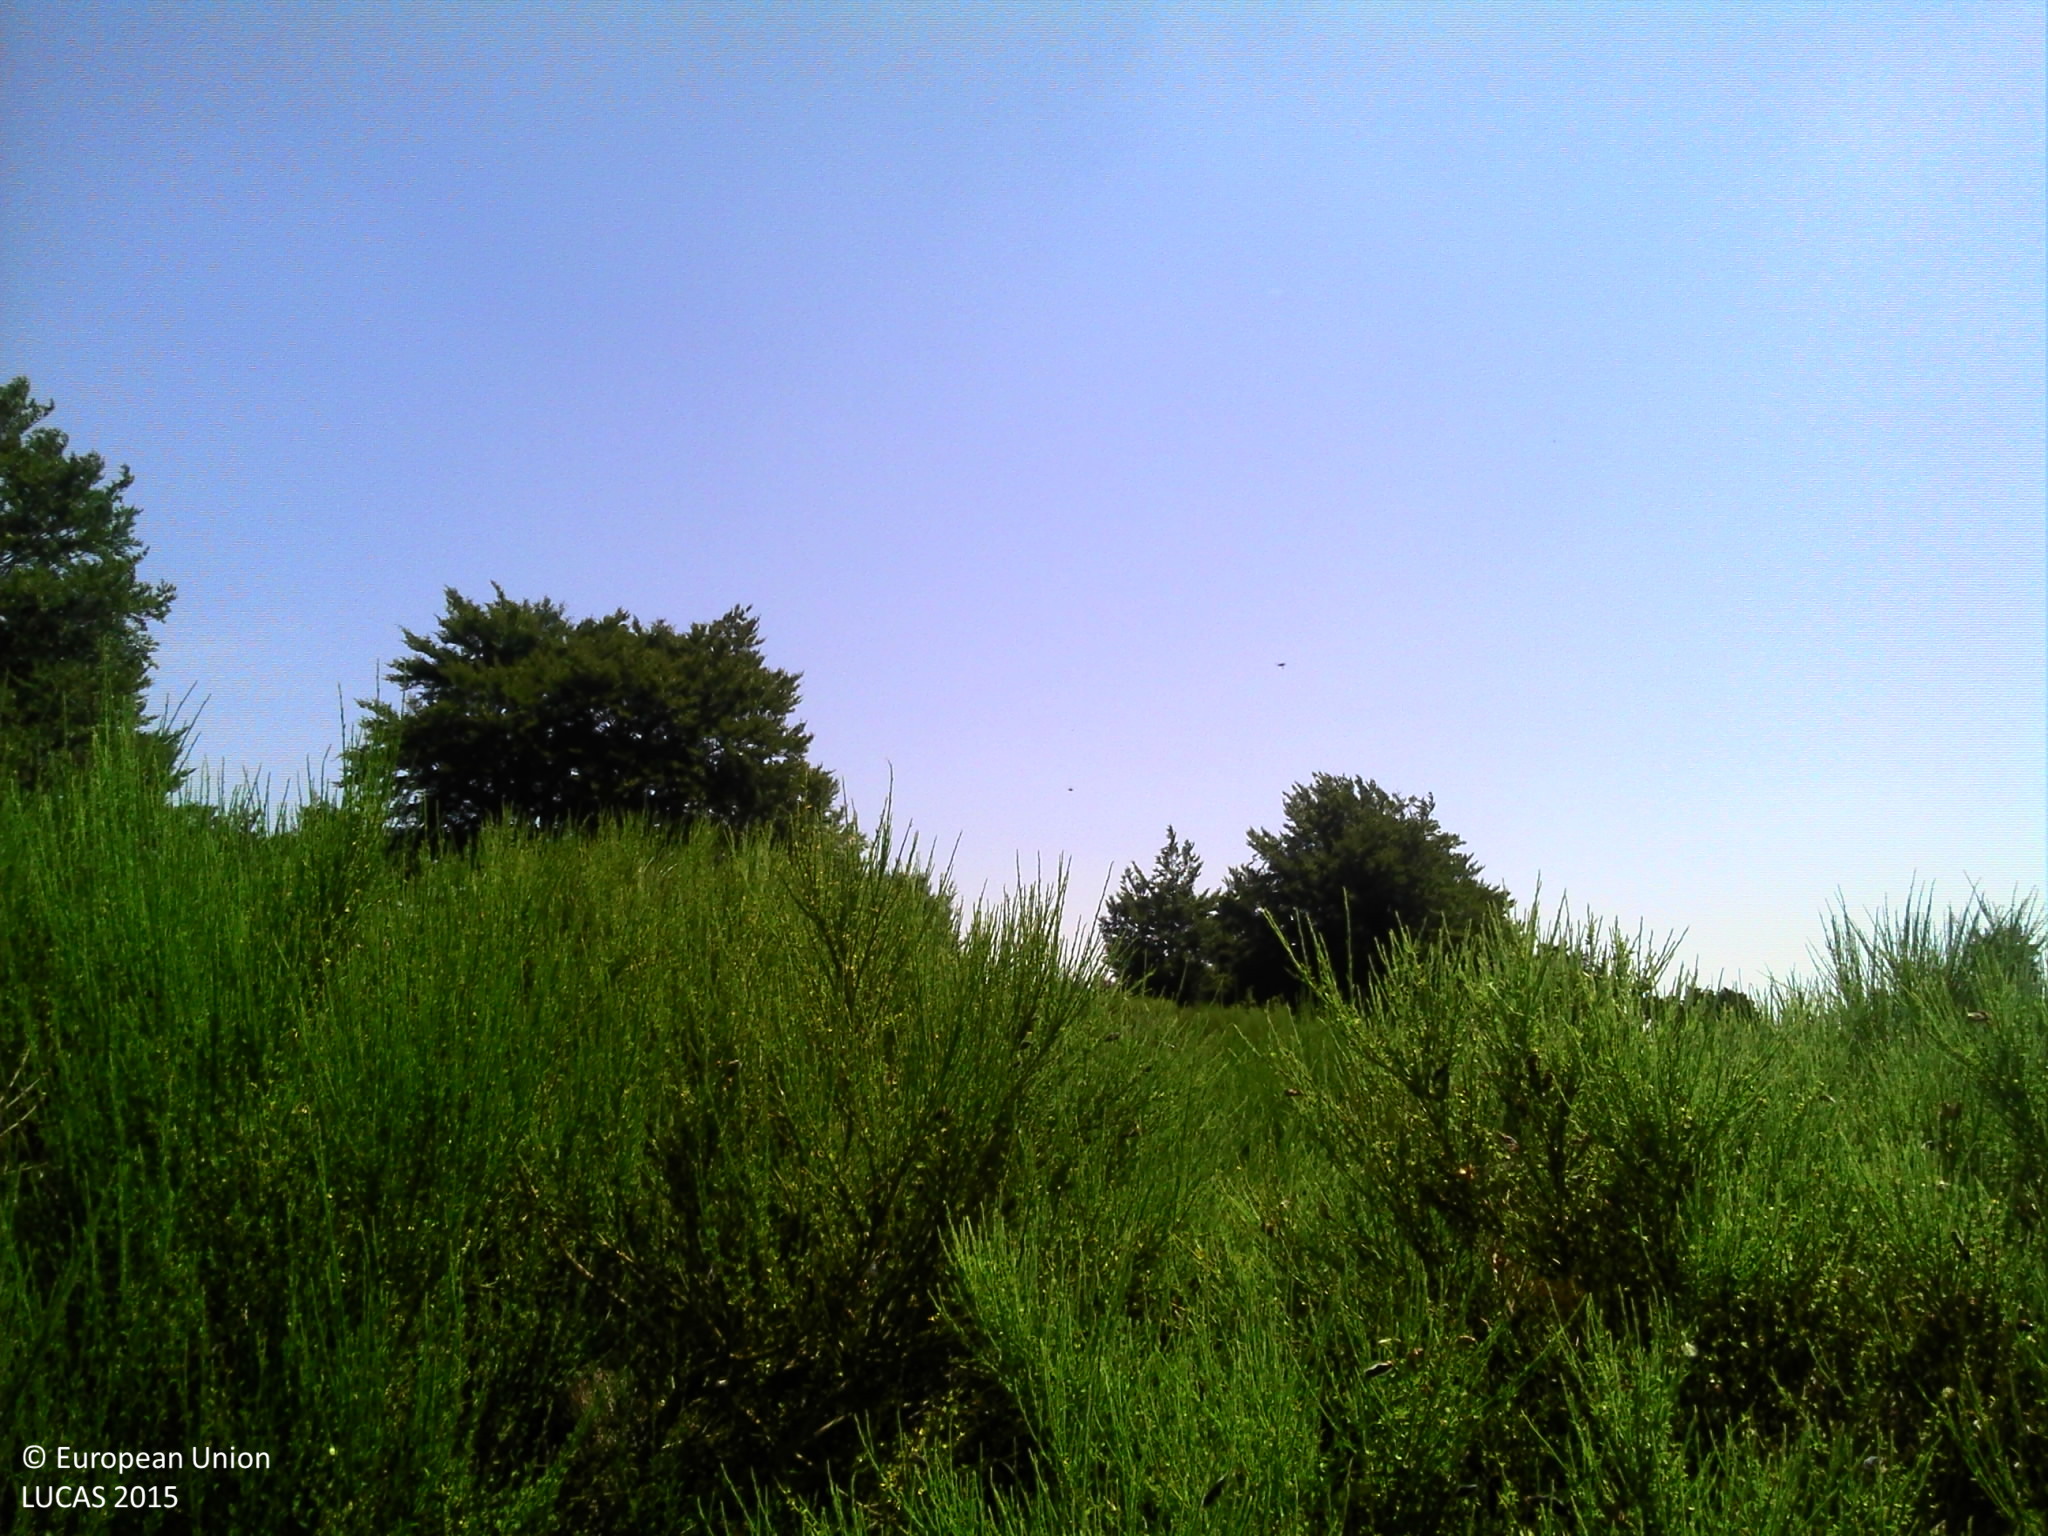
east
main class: Shrubland
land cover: Shrubland without tree cover
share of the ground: > 75 %
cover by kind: shrubs 90 %, herbaceous plants 10 %
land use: Agriculture (excluding fallow land and kitchen gardens)
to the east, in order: Shrubland without tree cover; Dry stone walls; Shrubland with sparse tree cover; Fences; Dry stone walls; Shrubland without tree cover
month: July
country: FR
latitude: 44.6330
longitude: 3.1844
